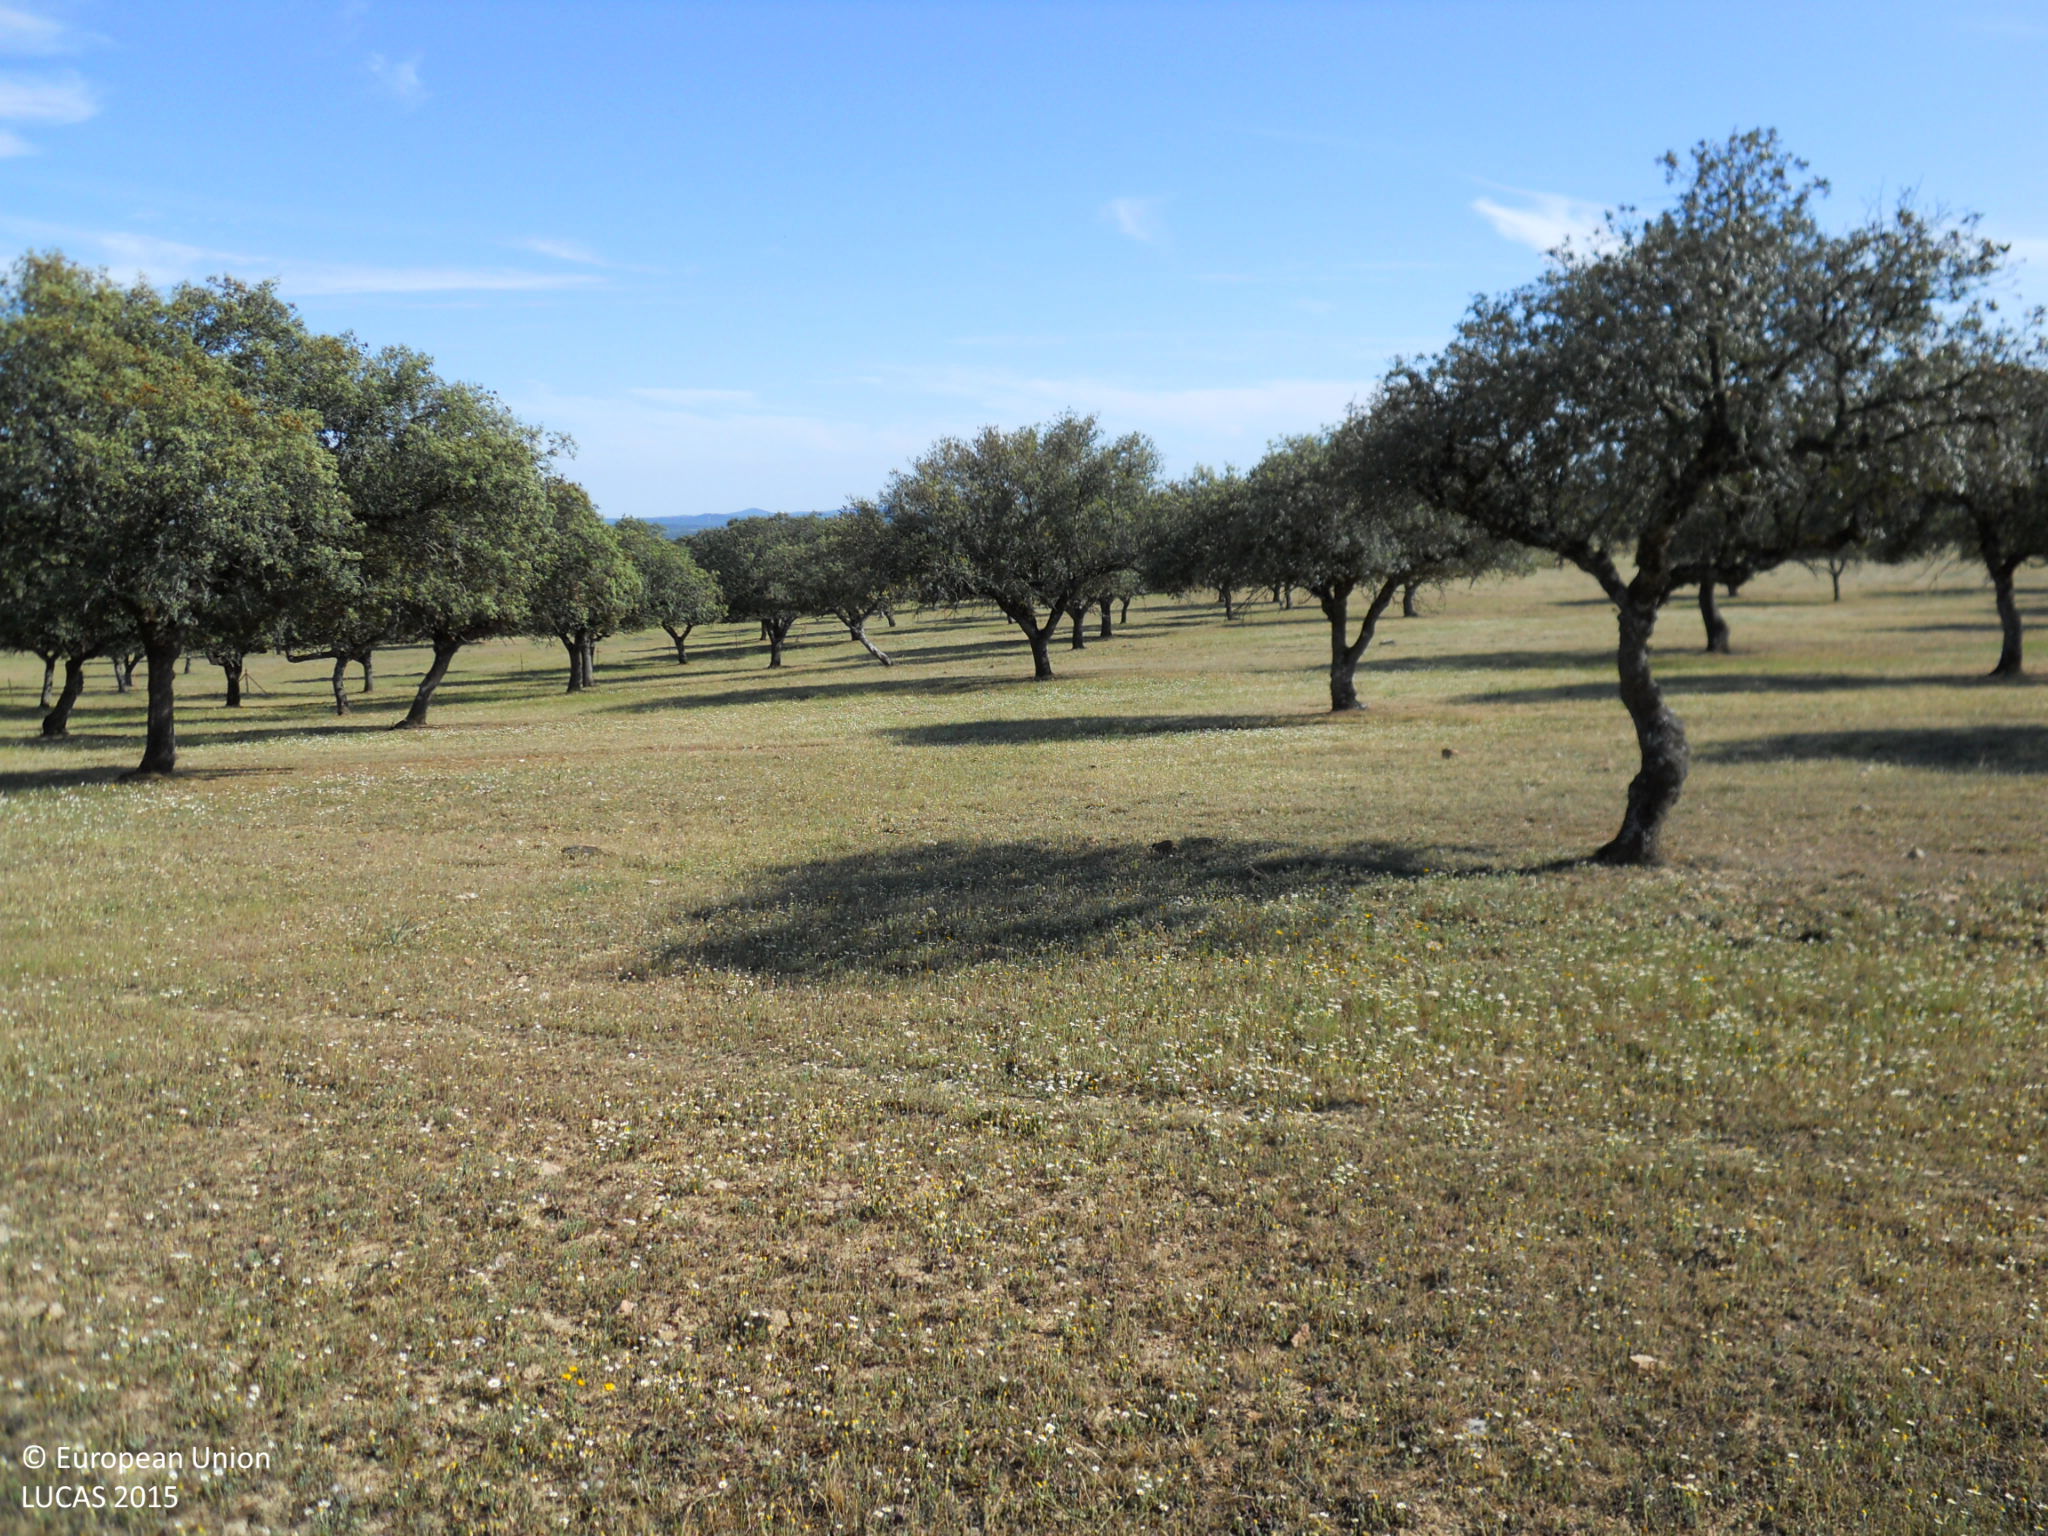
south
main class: Woodland
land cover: Broadleaved woodland
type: broadleaved evergreen forest
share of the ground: 25 - 50 %
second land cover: Grassland without tree/shrub cover
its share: > 75 %
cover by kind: herbaceous plants 65 %, broadleaved forest trees 35 %
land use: Forestry
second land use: Agriculture (excluding fallow land and kitchen gardens)
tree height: > 5 m
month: April
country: ES
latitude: 39.3579
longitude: -6.9167
